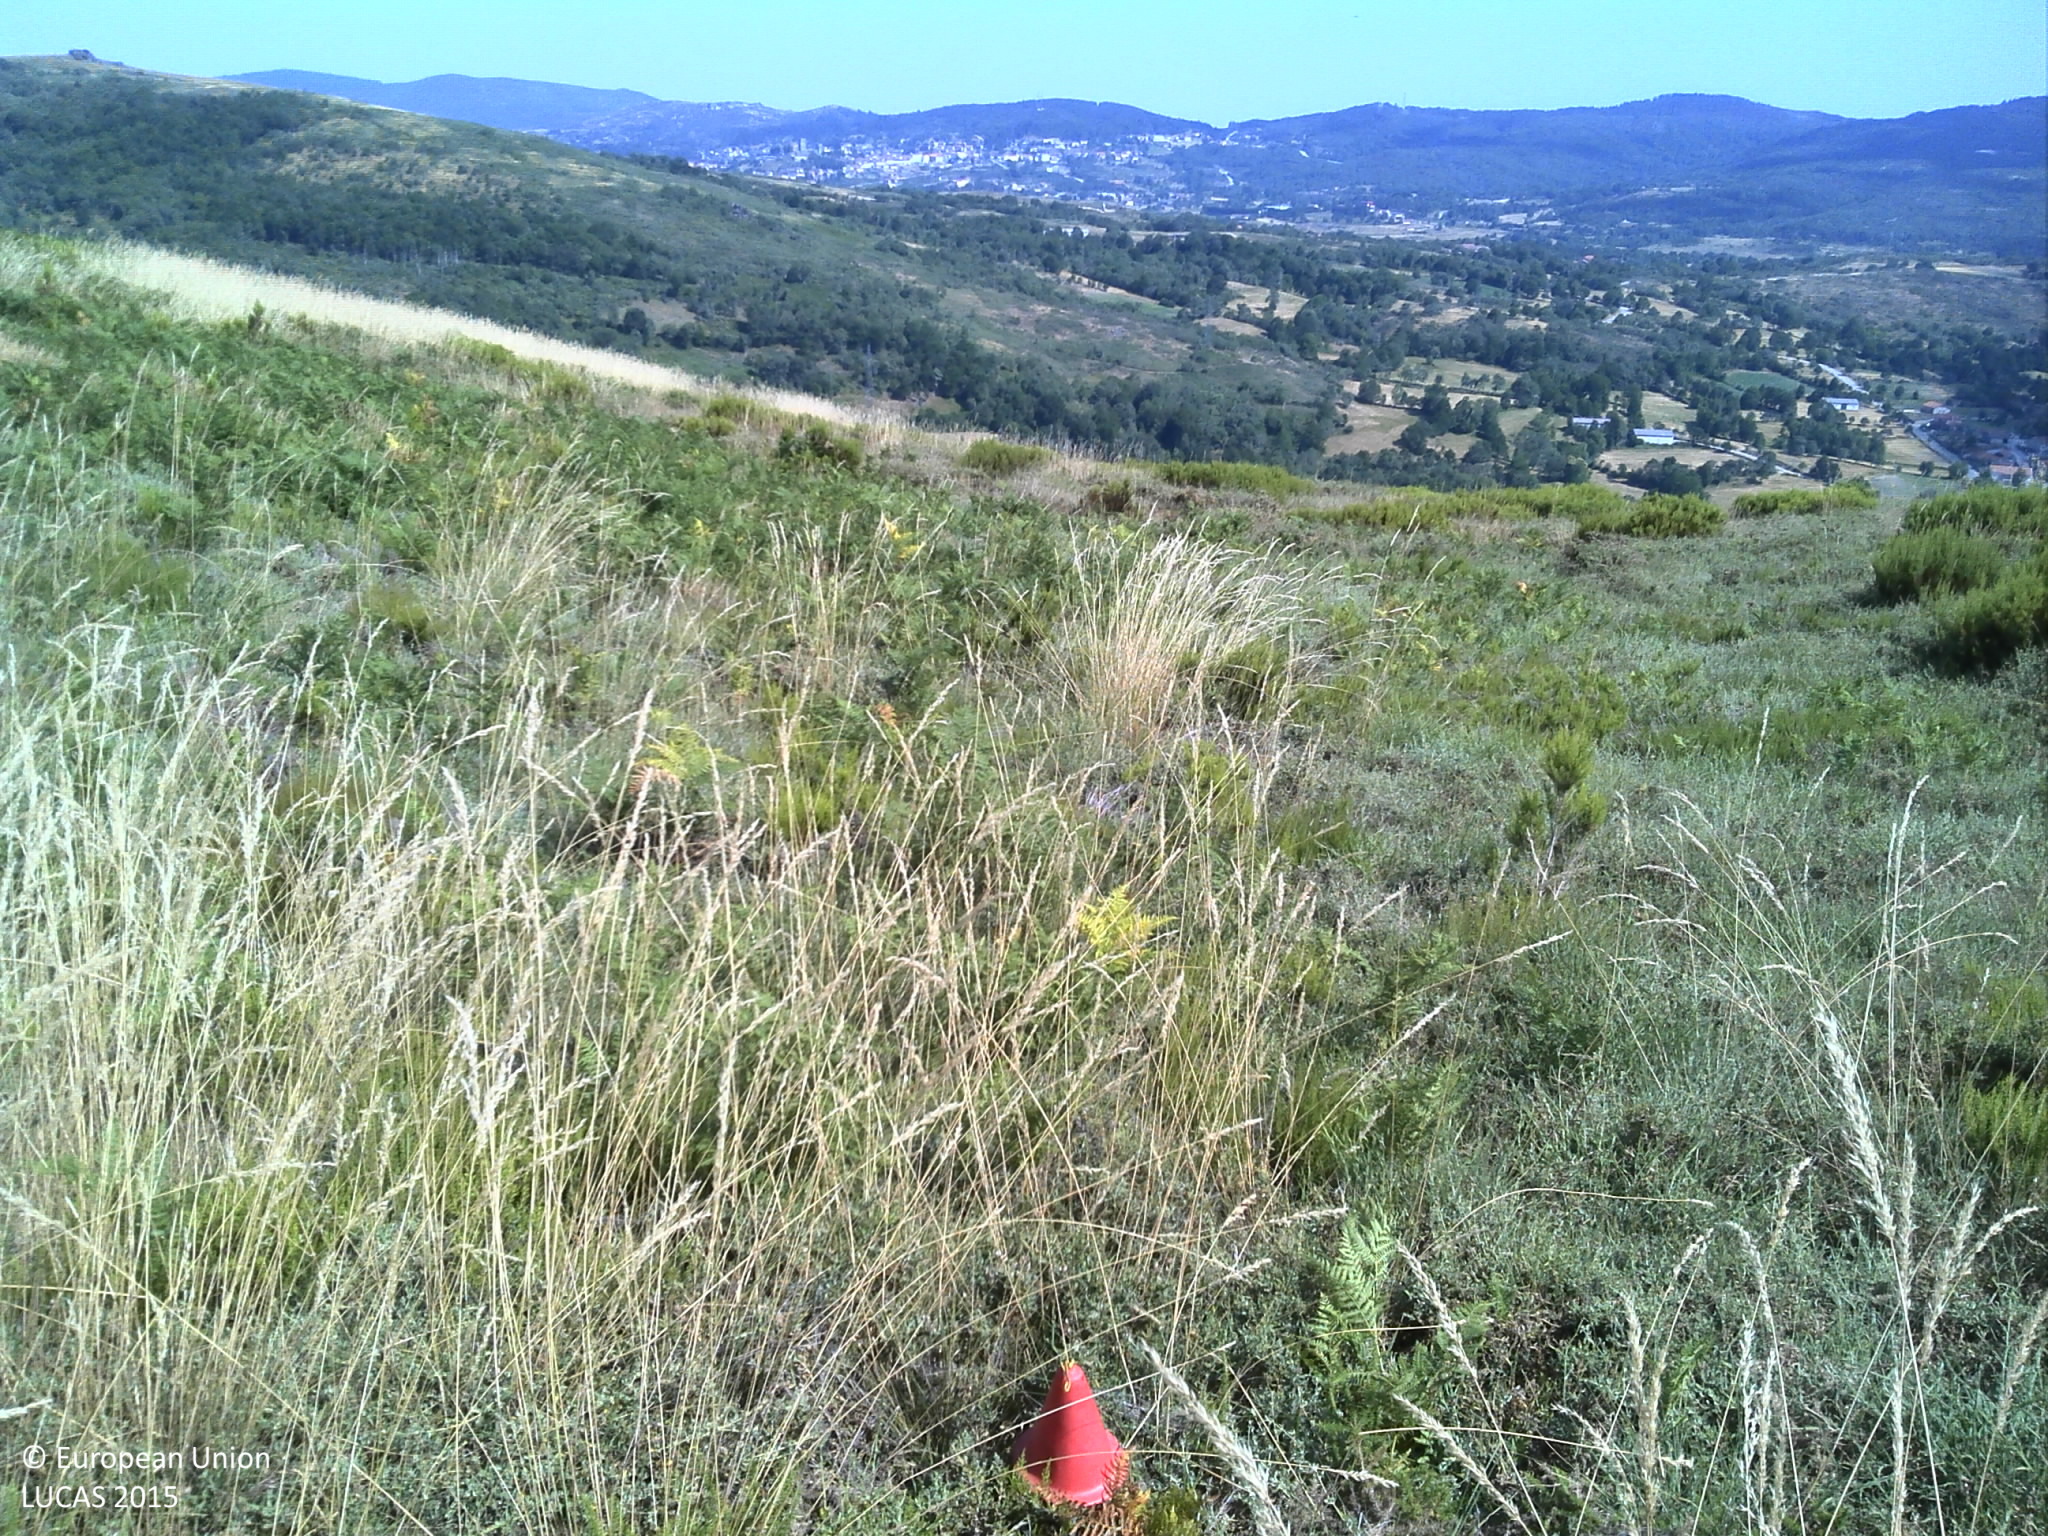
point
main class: Shrubland
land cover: Shrubland without tree cover
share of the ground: 50 - 75 %
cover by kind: shrubs 50 %, herbaceous plants 50 %
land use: Agriculture (excluding fallow land and kitchen gardens)
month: July
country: PT
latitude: 41.8493
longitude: -7.8350
